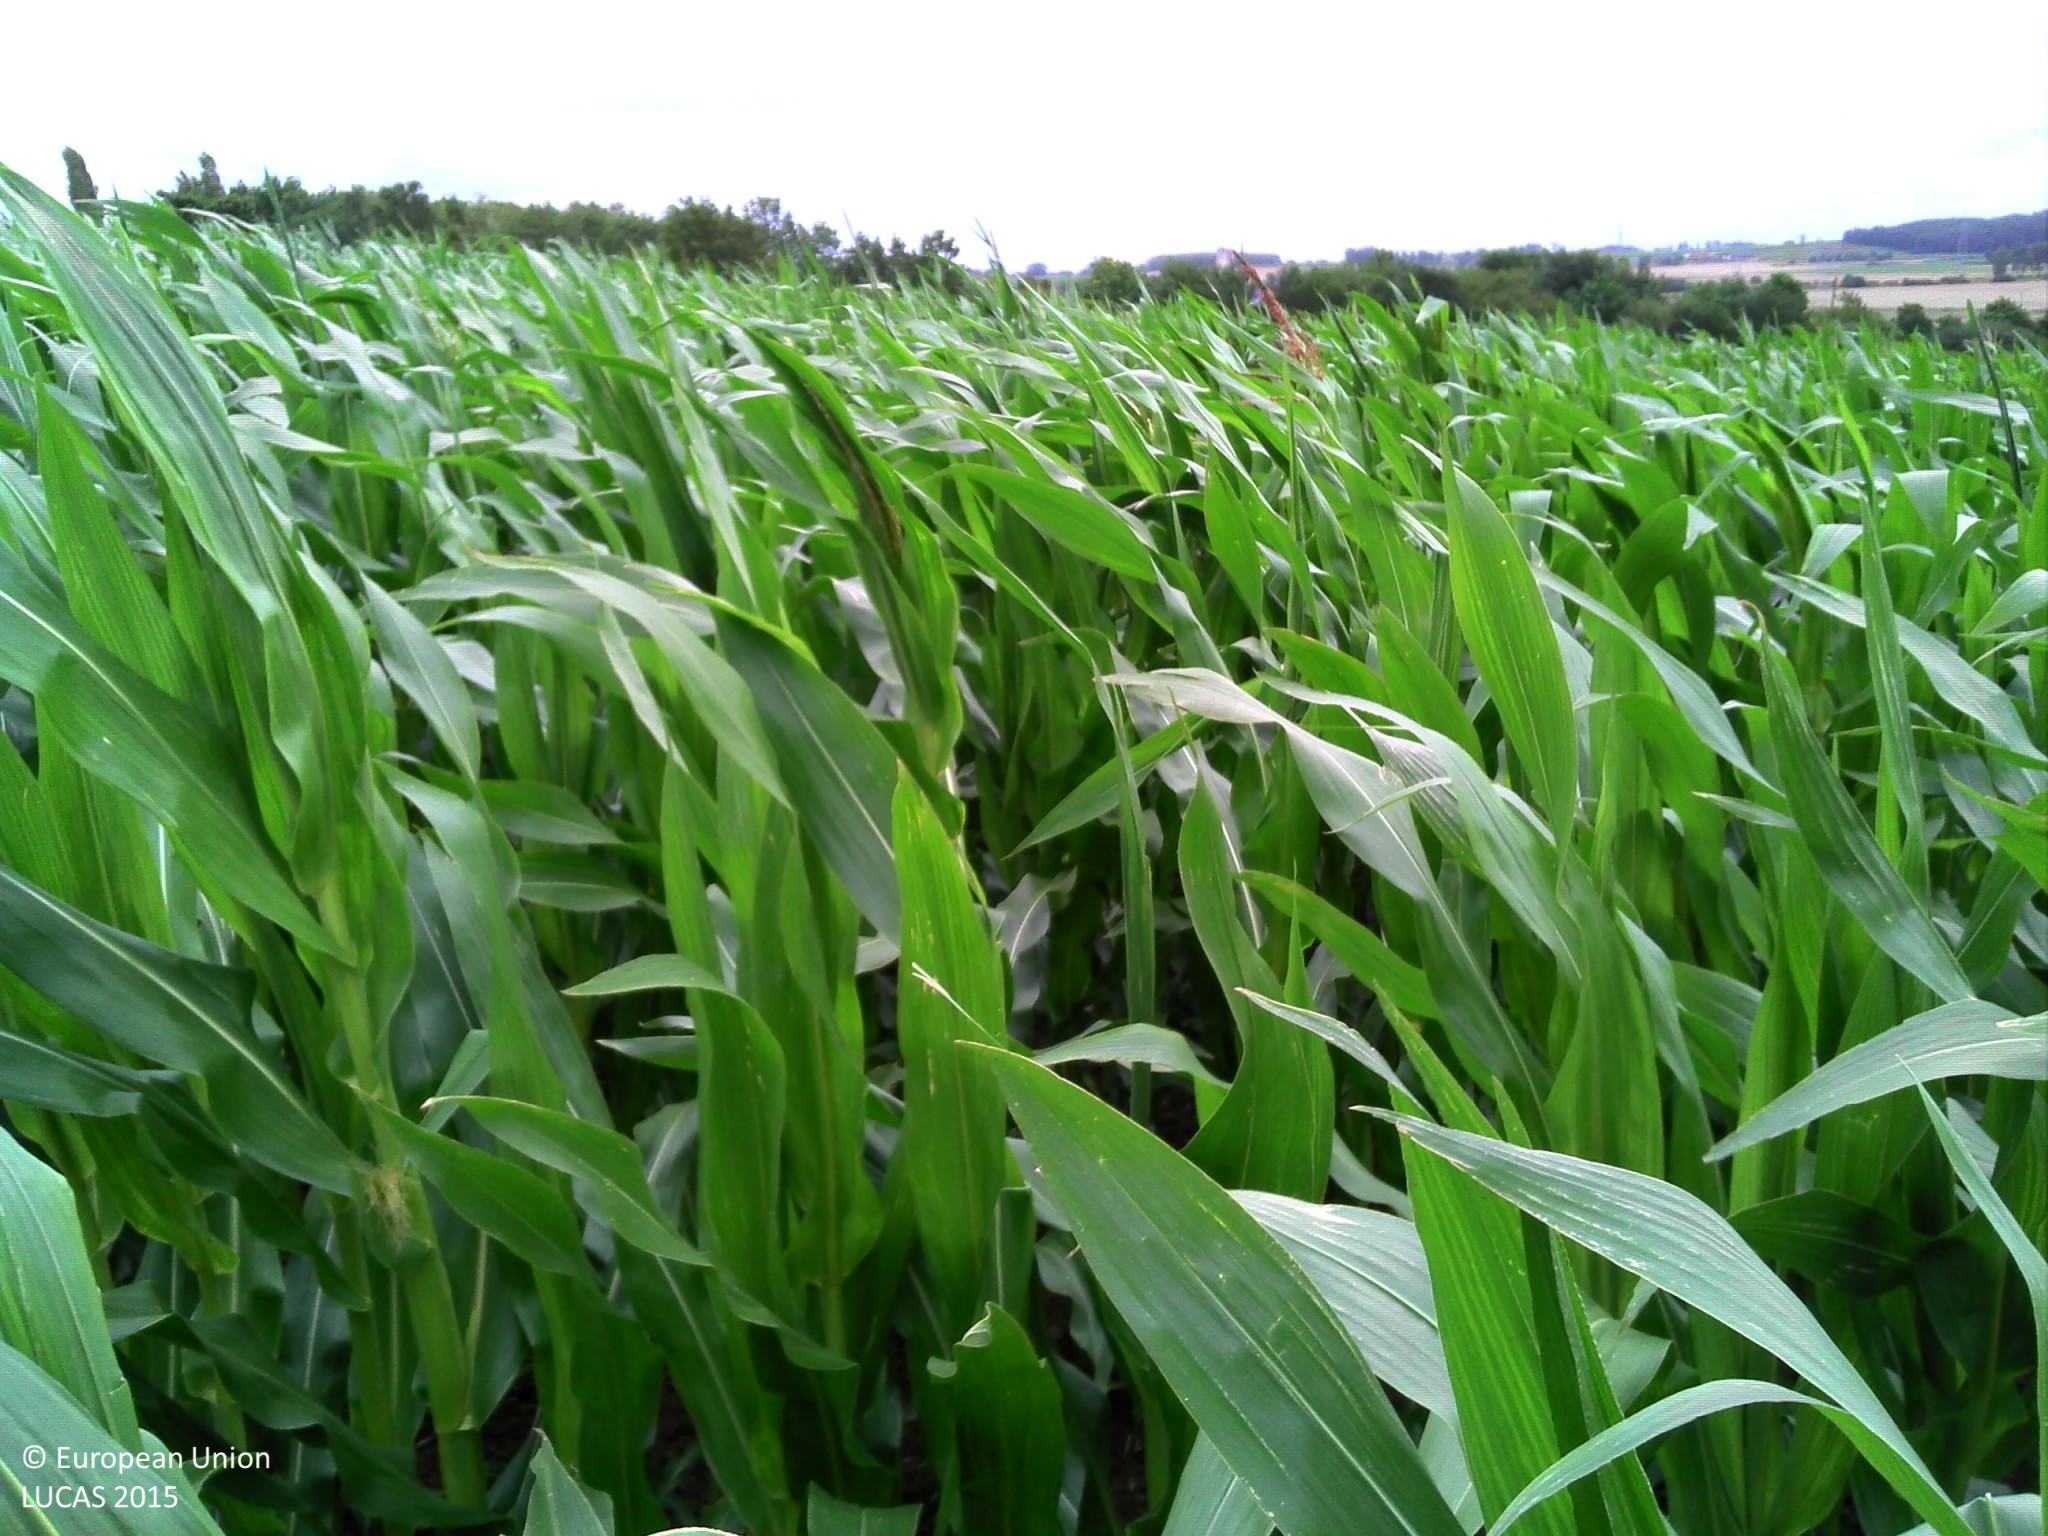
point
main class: Cropland
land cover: Maize
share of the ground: > 75 %
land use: Agriculture (excluding fallow land and kitchen gardens)
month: July
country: FR
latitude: 50.7435
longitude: 2.4049
